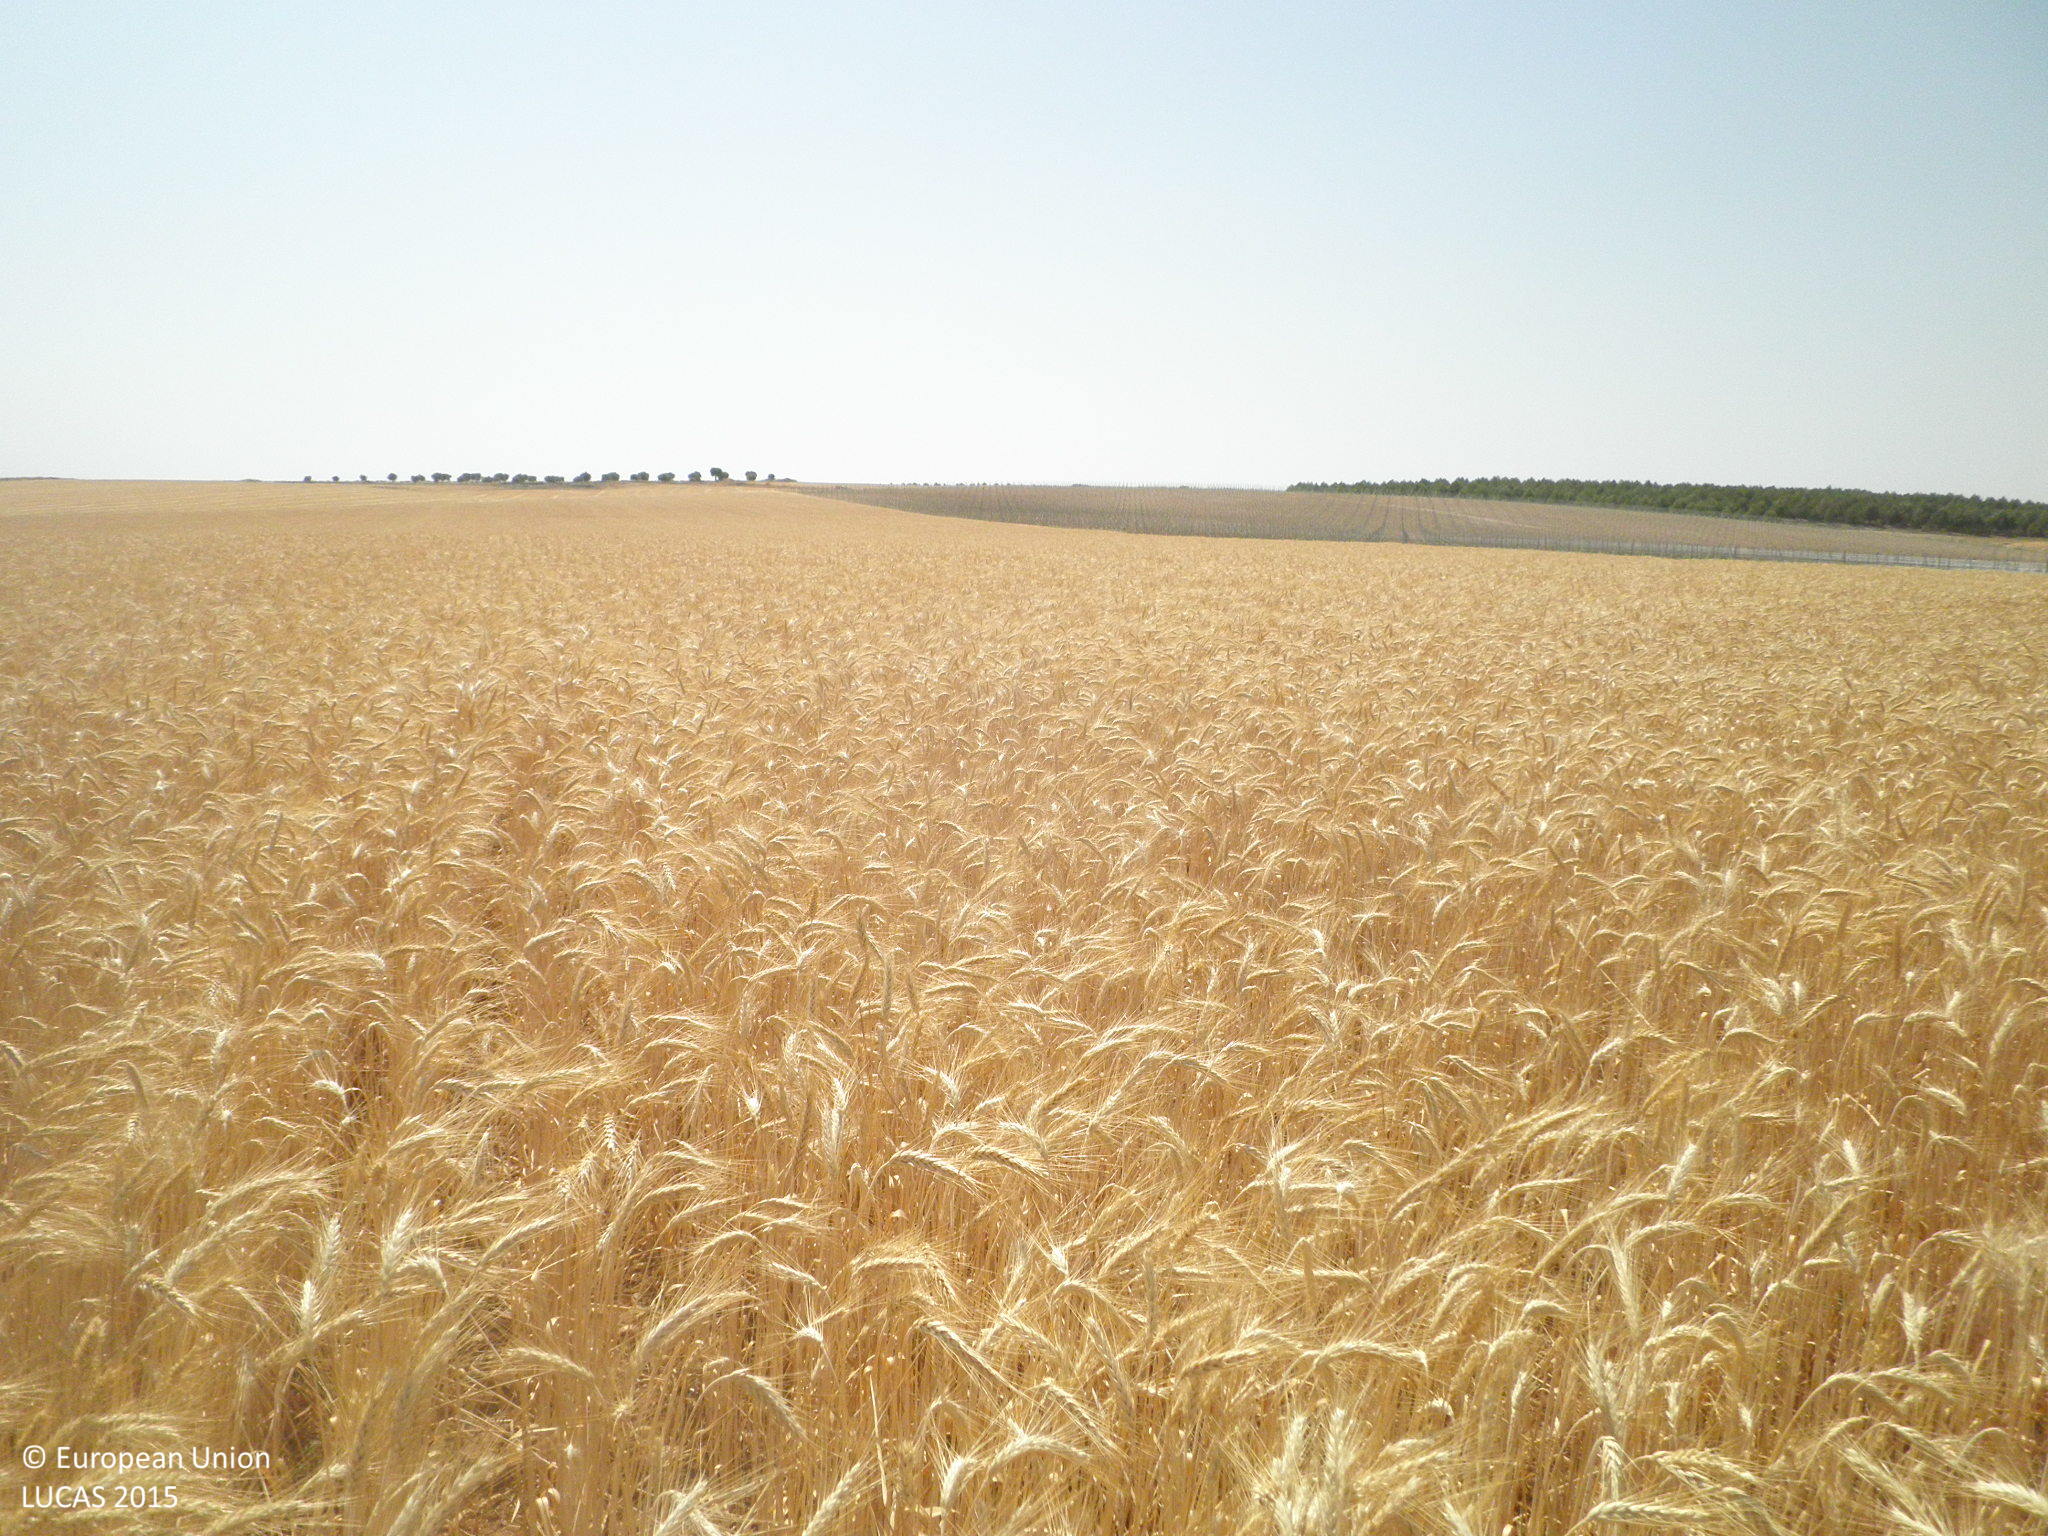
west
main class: Cropland
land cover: Durum wheat
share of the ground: > 75 %
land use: Agriculture (excluding fallow land and kitchen gardens)
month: July
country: ES
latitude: 39.4696
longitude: -2.6014
